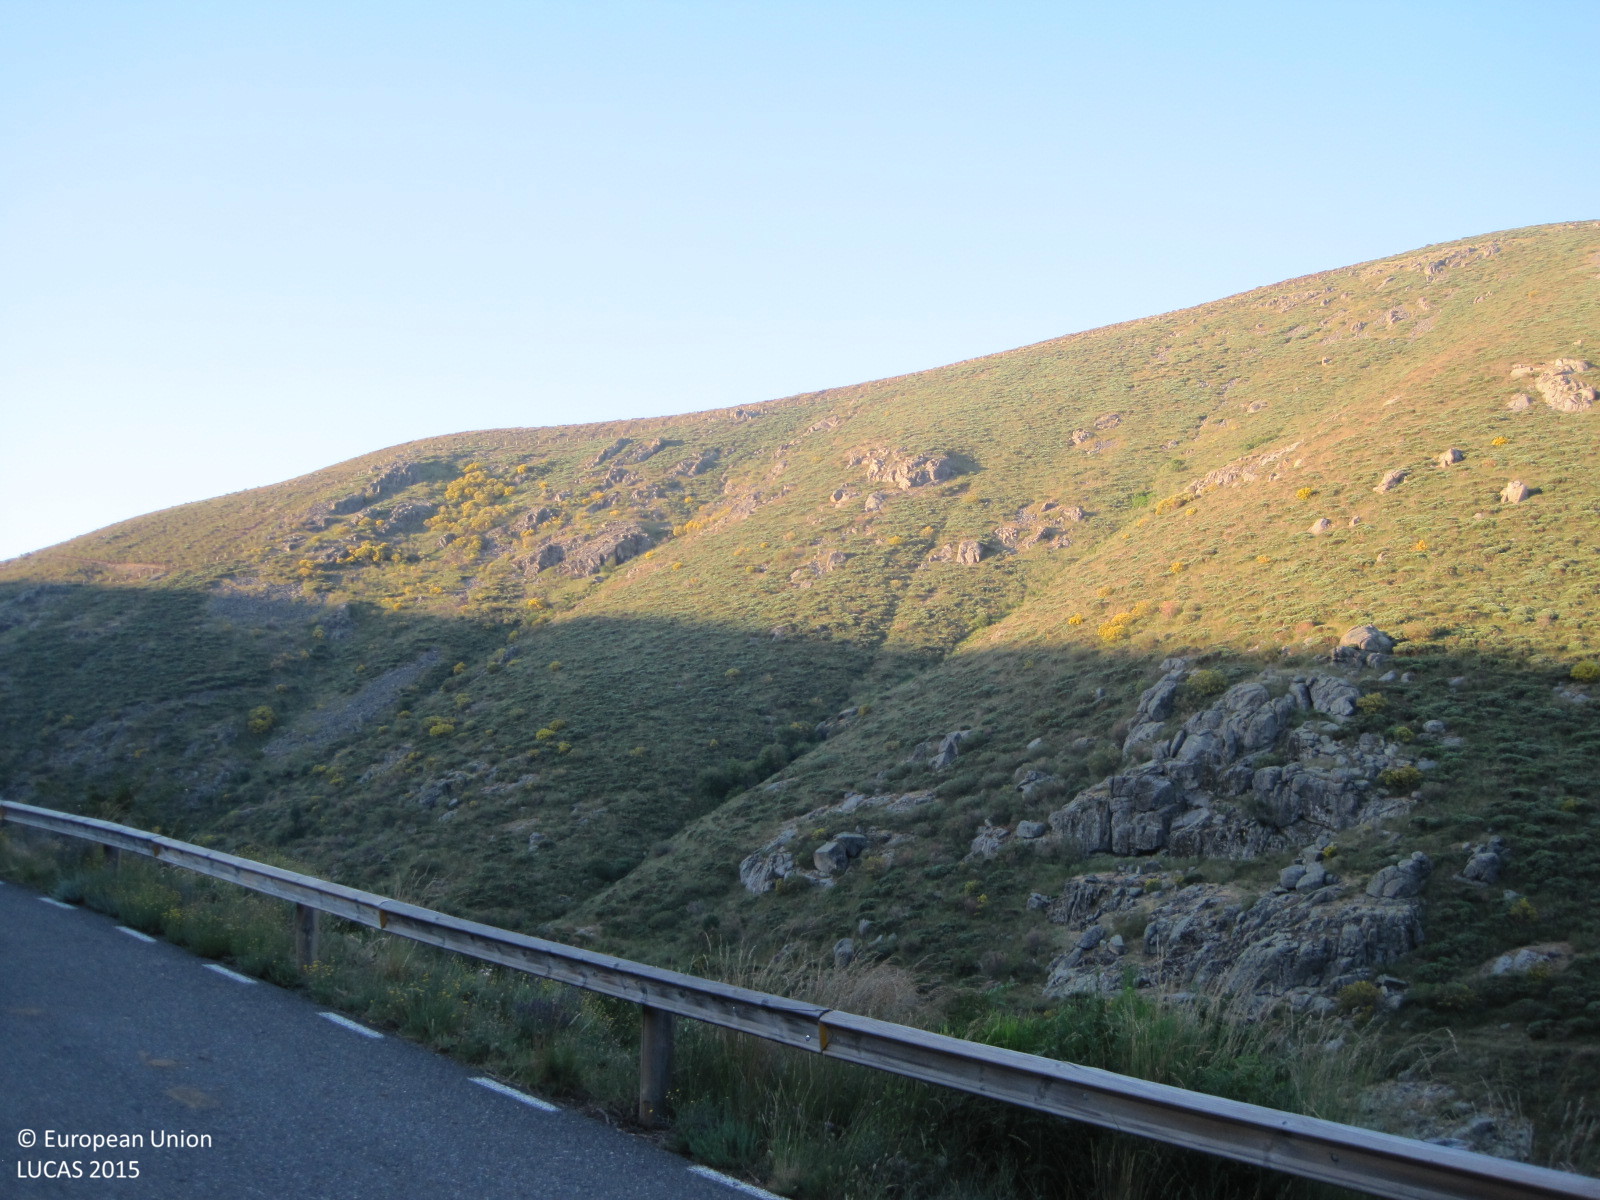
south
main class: Shrubland
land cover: Shrubland without tree cover
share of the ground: > 75 %
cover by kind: shrubs 100 %
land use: Semi-natural and natural areas not in use
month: June
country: ES
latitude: 40.3375
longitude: -5.2335
